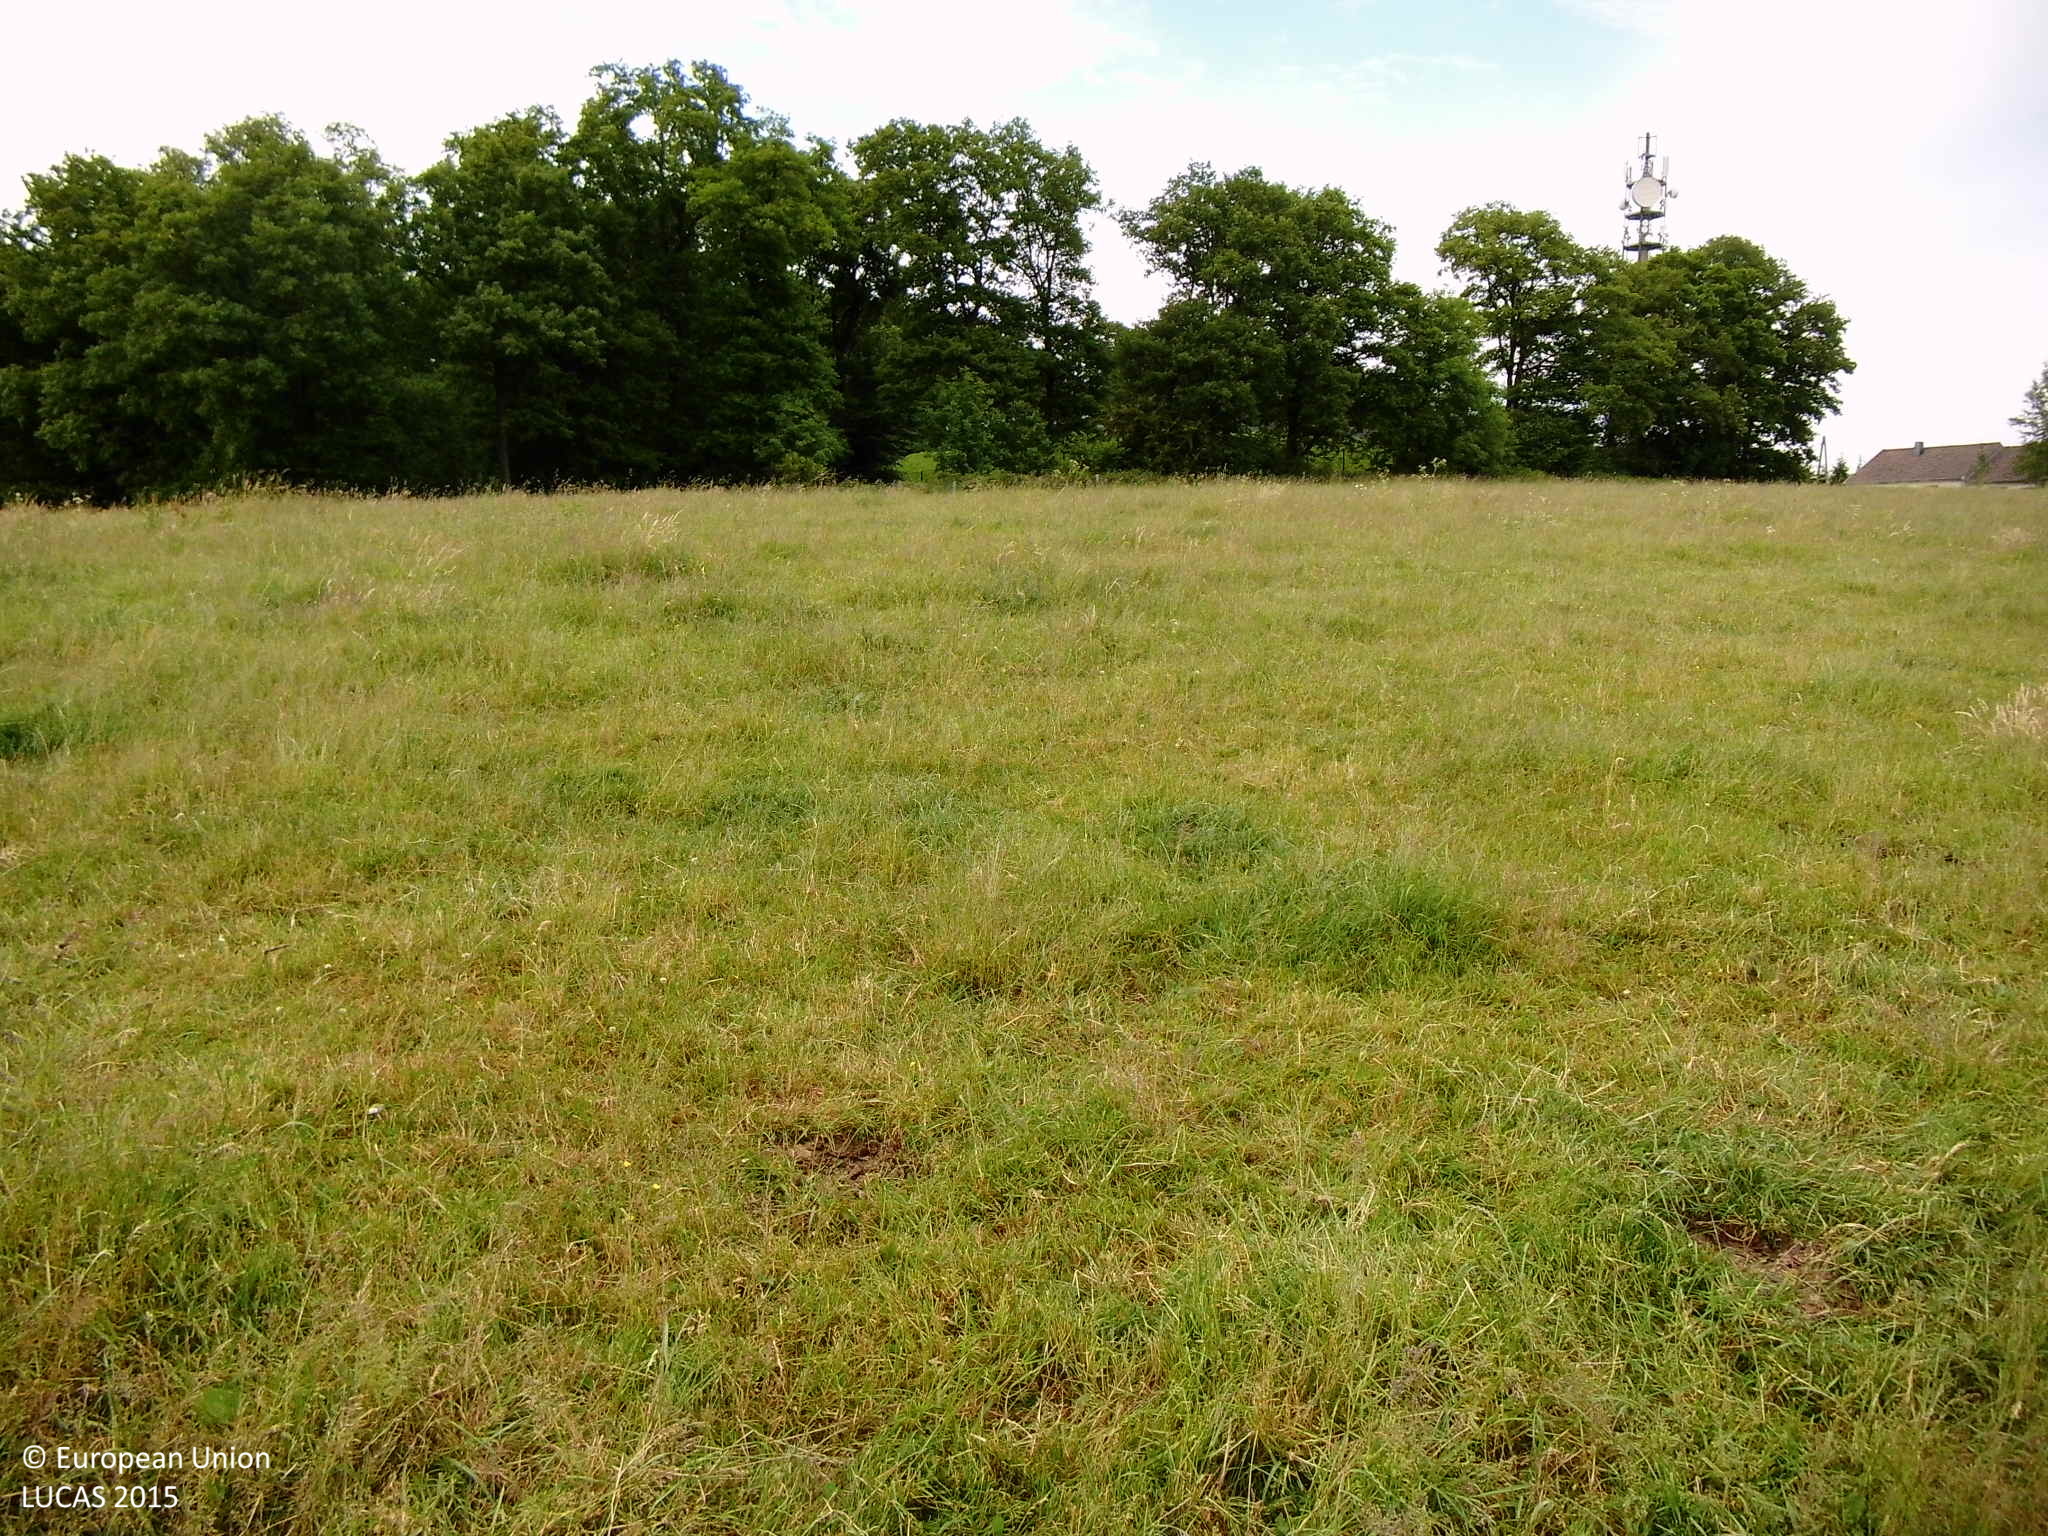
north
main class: Grassland
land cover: Grassland without tree/shrub cover
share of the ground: > 75 %
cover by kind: herbaceous plants 100 %
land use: Agriculture (excluding fallow land and kitchen gardens)
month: June
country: DE
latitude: 51.1982
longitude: 7.4099
